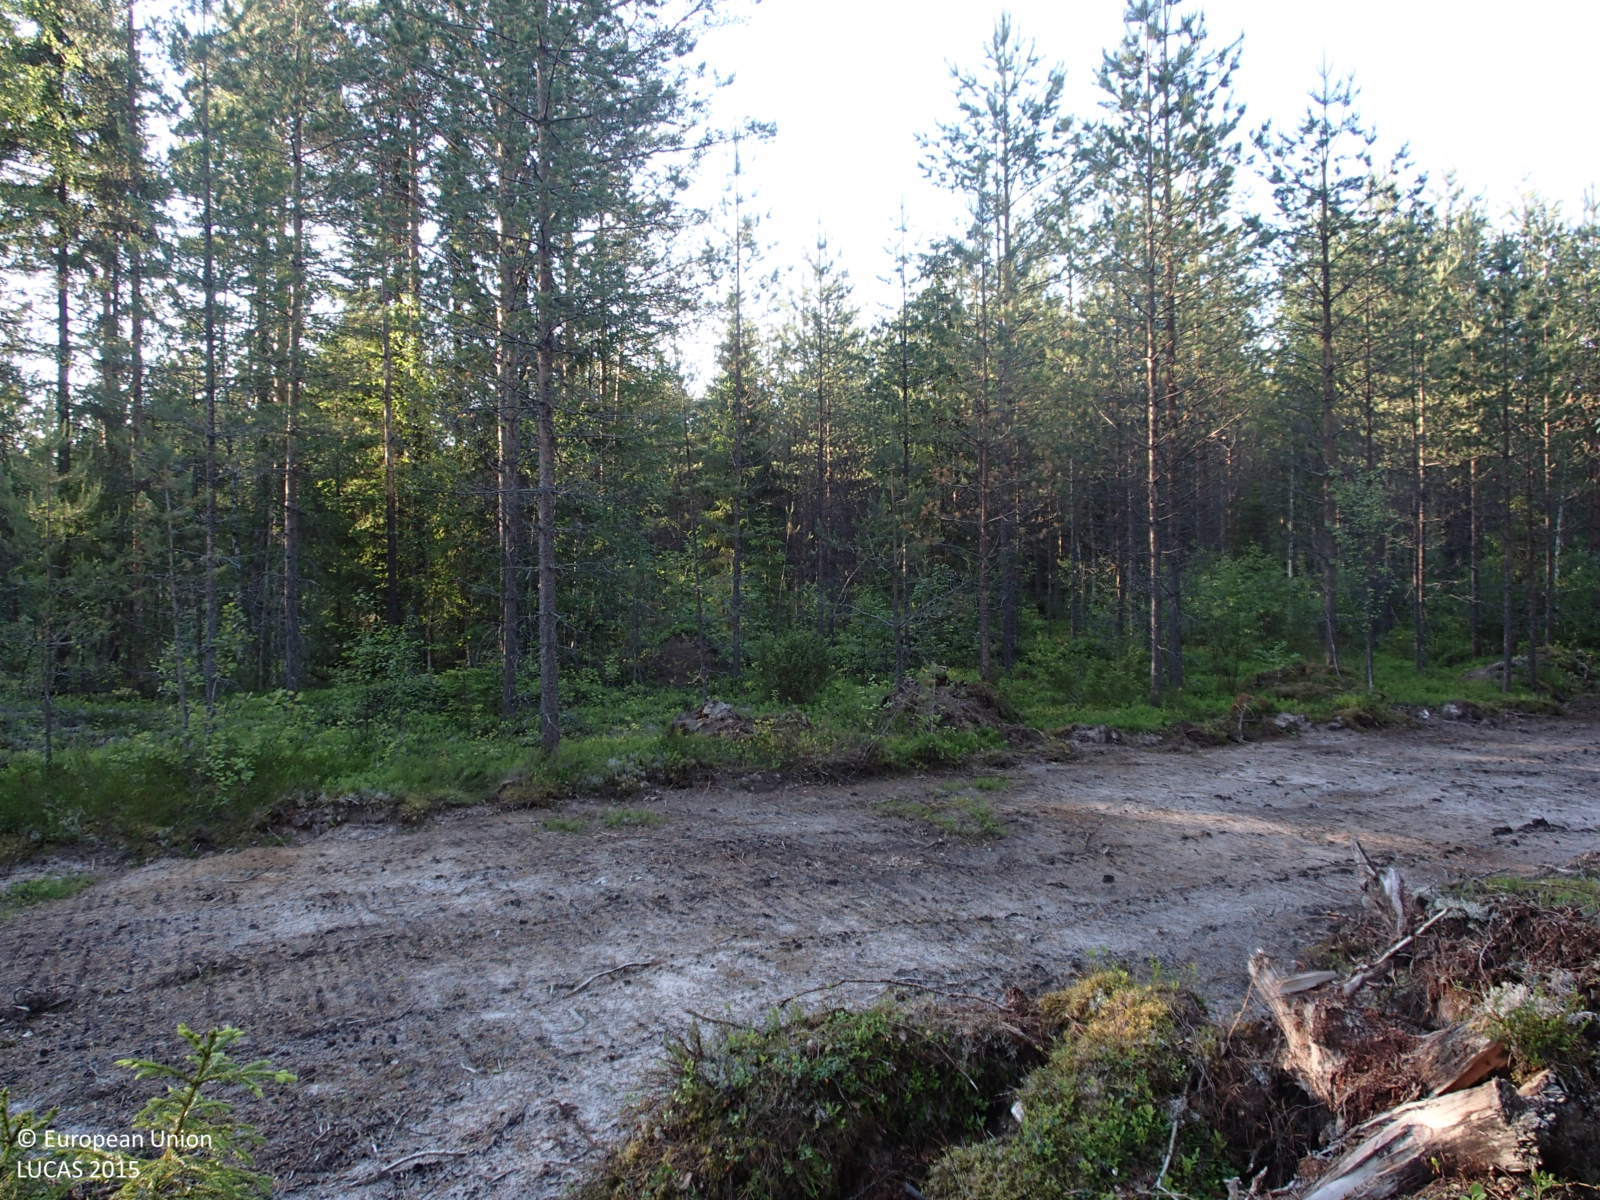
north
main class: Woodland
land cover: Pine dominated coniferous woodland
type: boreal forest
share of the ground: 50 - 75 %
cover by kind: coniferous forest trees 55 %, shrubs 25 %, lichens and mosses 20 %
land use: Forestry
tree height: > 5 m
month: July
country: FI
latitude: 64.0470
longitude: 27.1578
